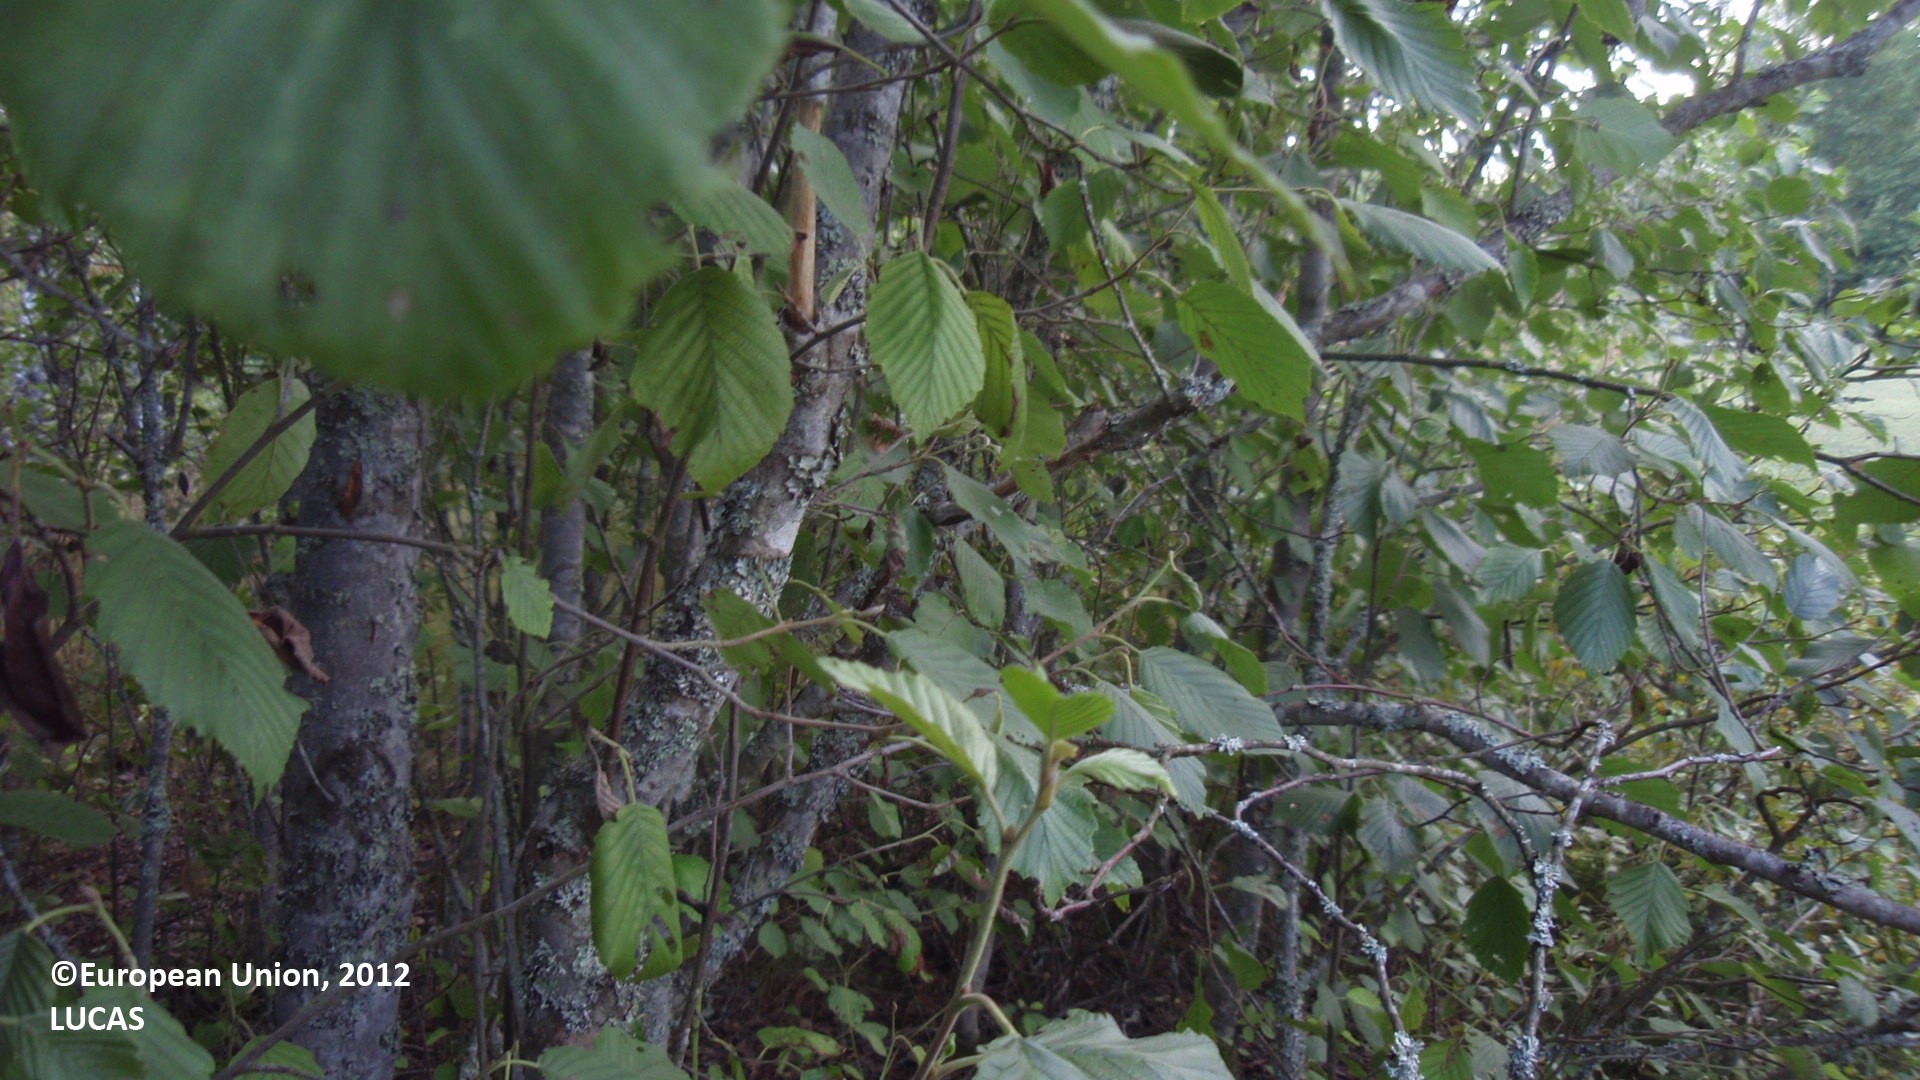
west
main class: Woodland
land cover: Broadleaved woodland
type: non-riverine alder, birch or aspen forest
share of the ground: > 75 %
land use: Forestry
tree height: > 5 m
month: August
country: FI
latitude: 60.6716
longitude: 26.6870
